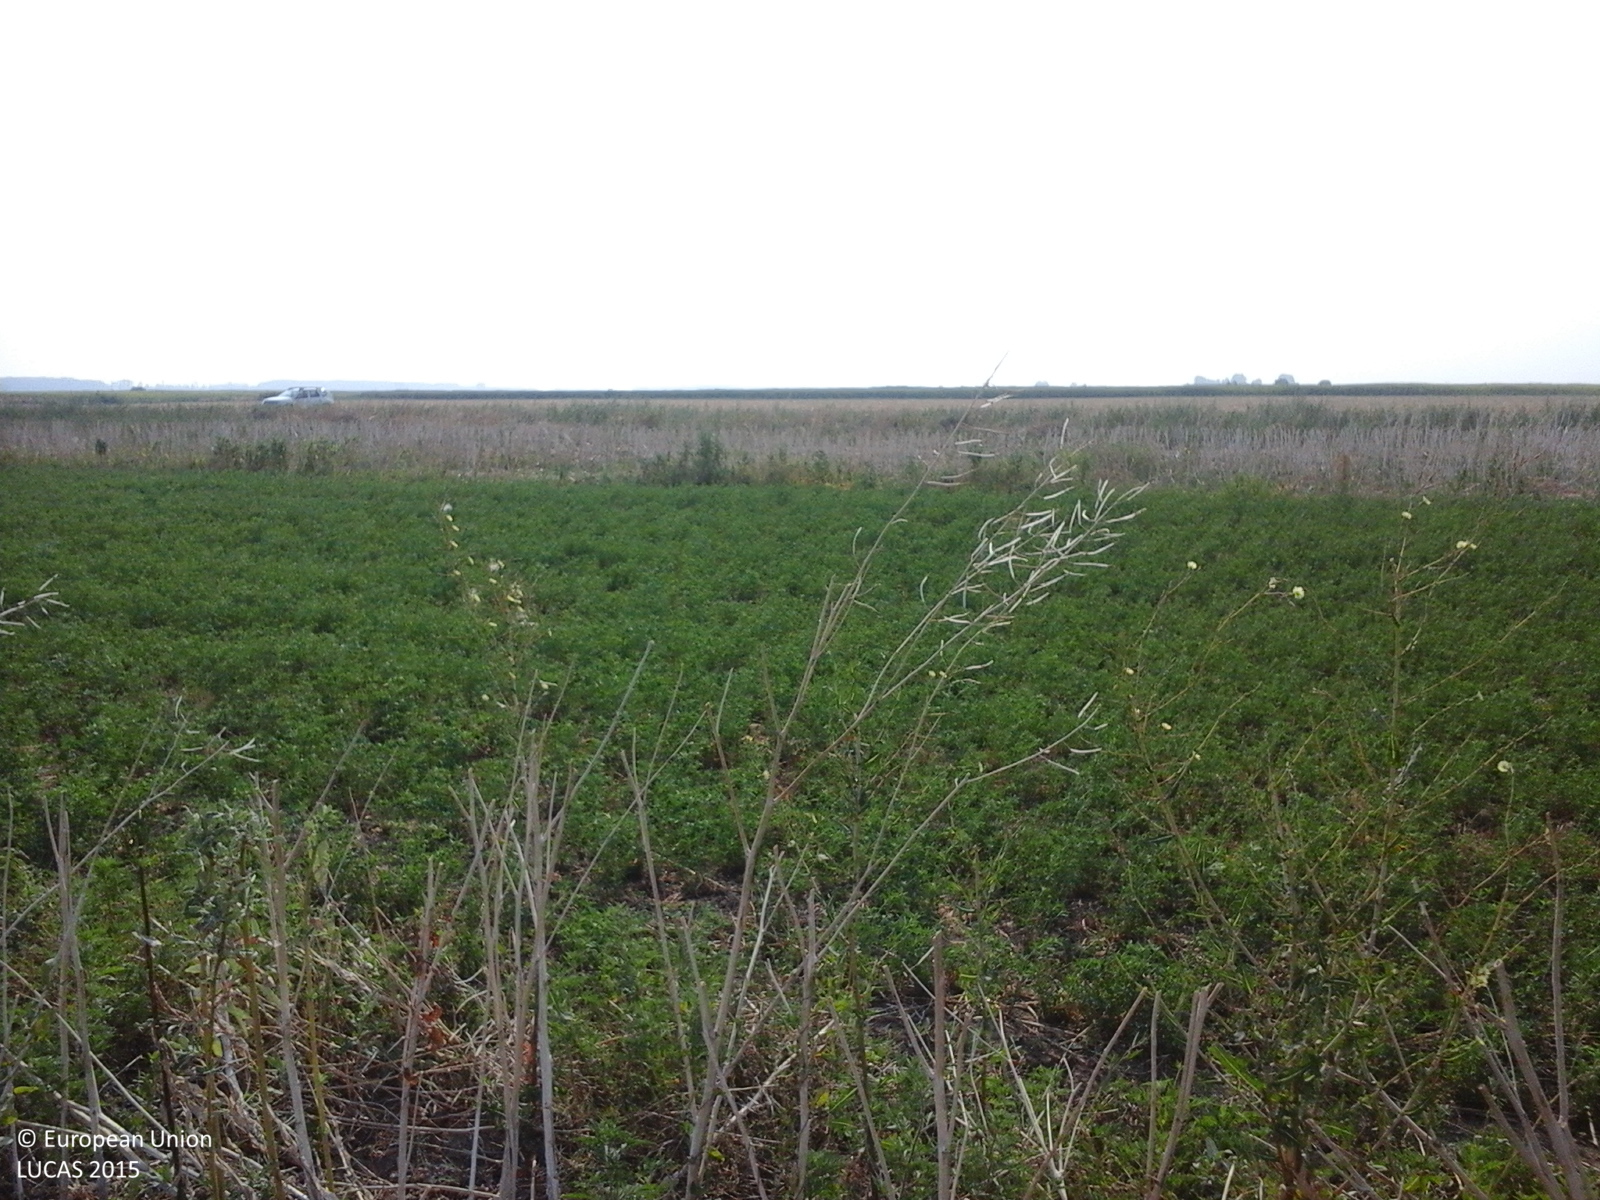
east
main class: Cropland
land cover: Rape and turnip rape
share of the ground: < 10 %
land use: Agriculture (excluding fallow land and kitchen gardens)
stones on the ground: < 10 %
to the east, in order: Rape and turnip rape; Lucerne; Rape and turnip rape; Common wheat
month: July
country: RO
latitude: 45.4173
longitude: 28.1000
